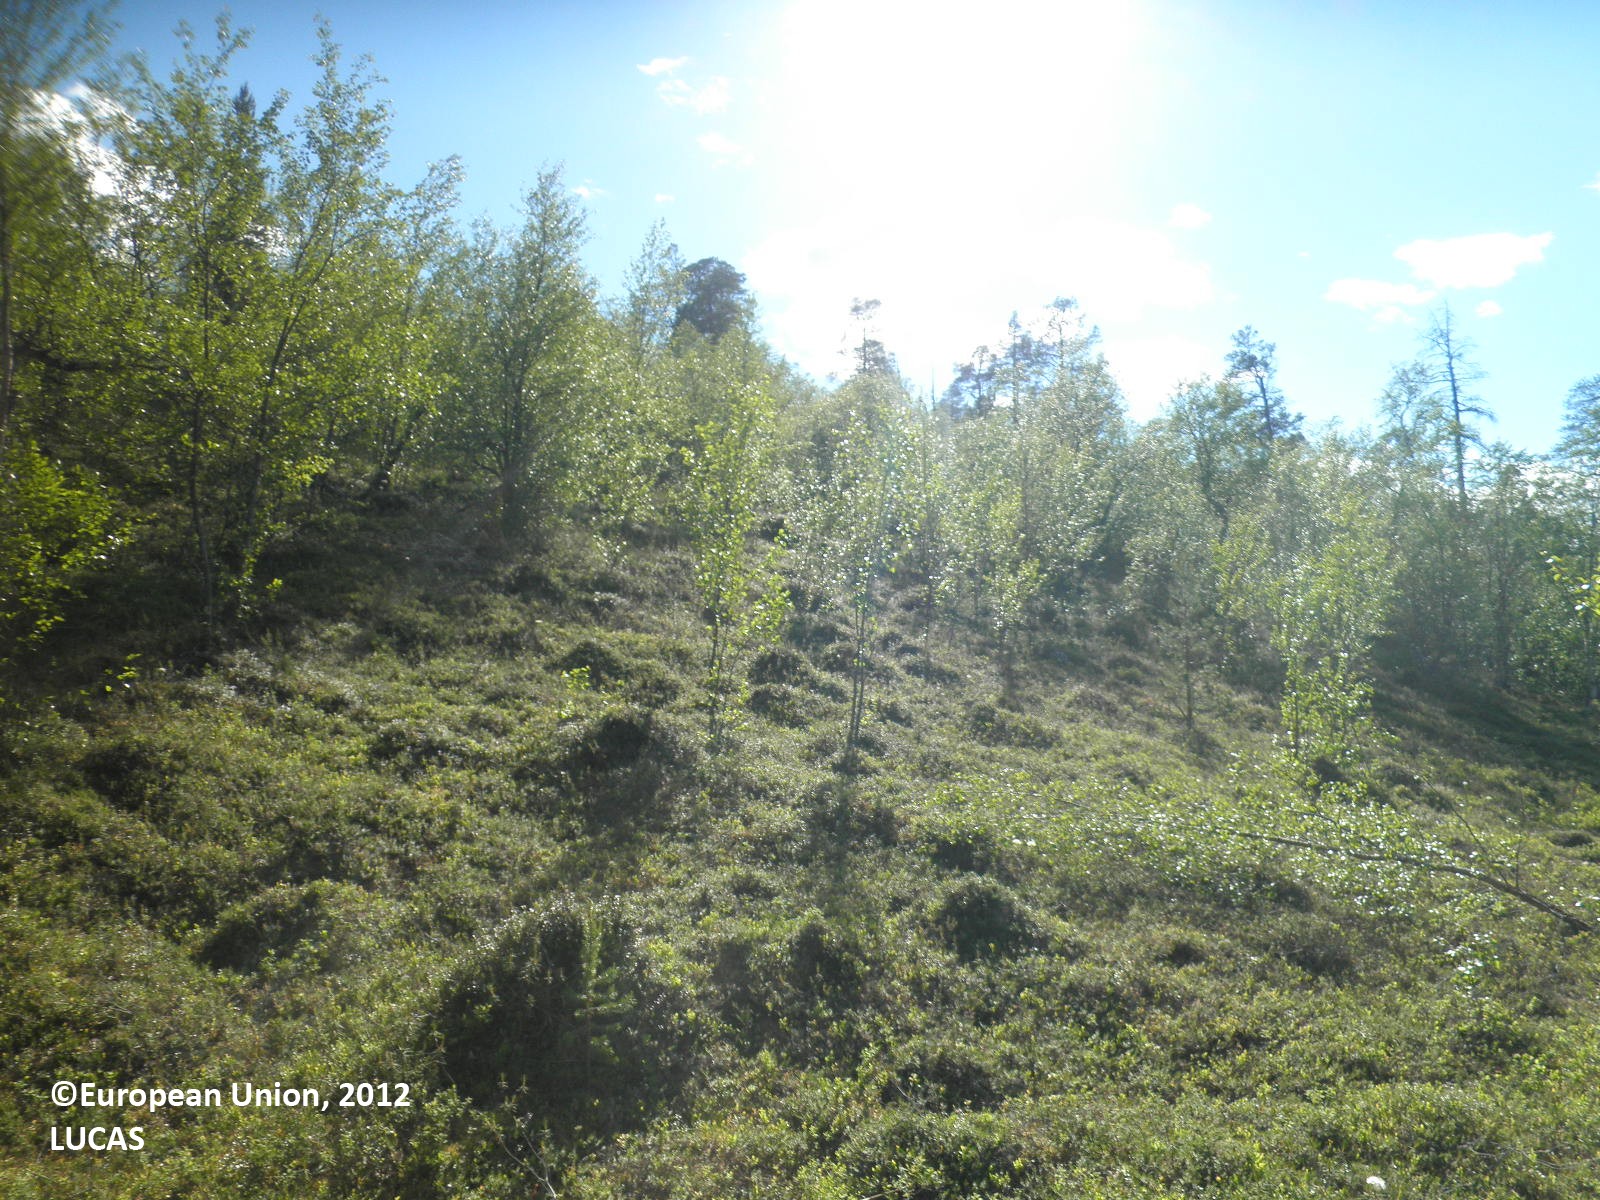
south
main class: Woodland
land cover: Pine dominated mixed woodland
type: boreal forest
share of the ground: 50 - 75 %
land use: Forestry
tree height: > 5 m
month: July
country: FI
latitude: 68.8932
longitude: 27.0051
